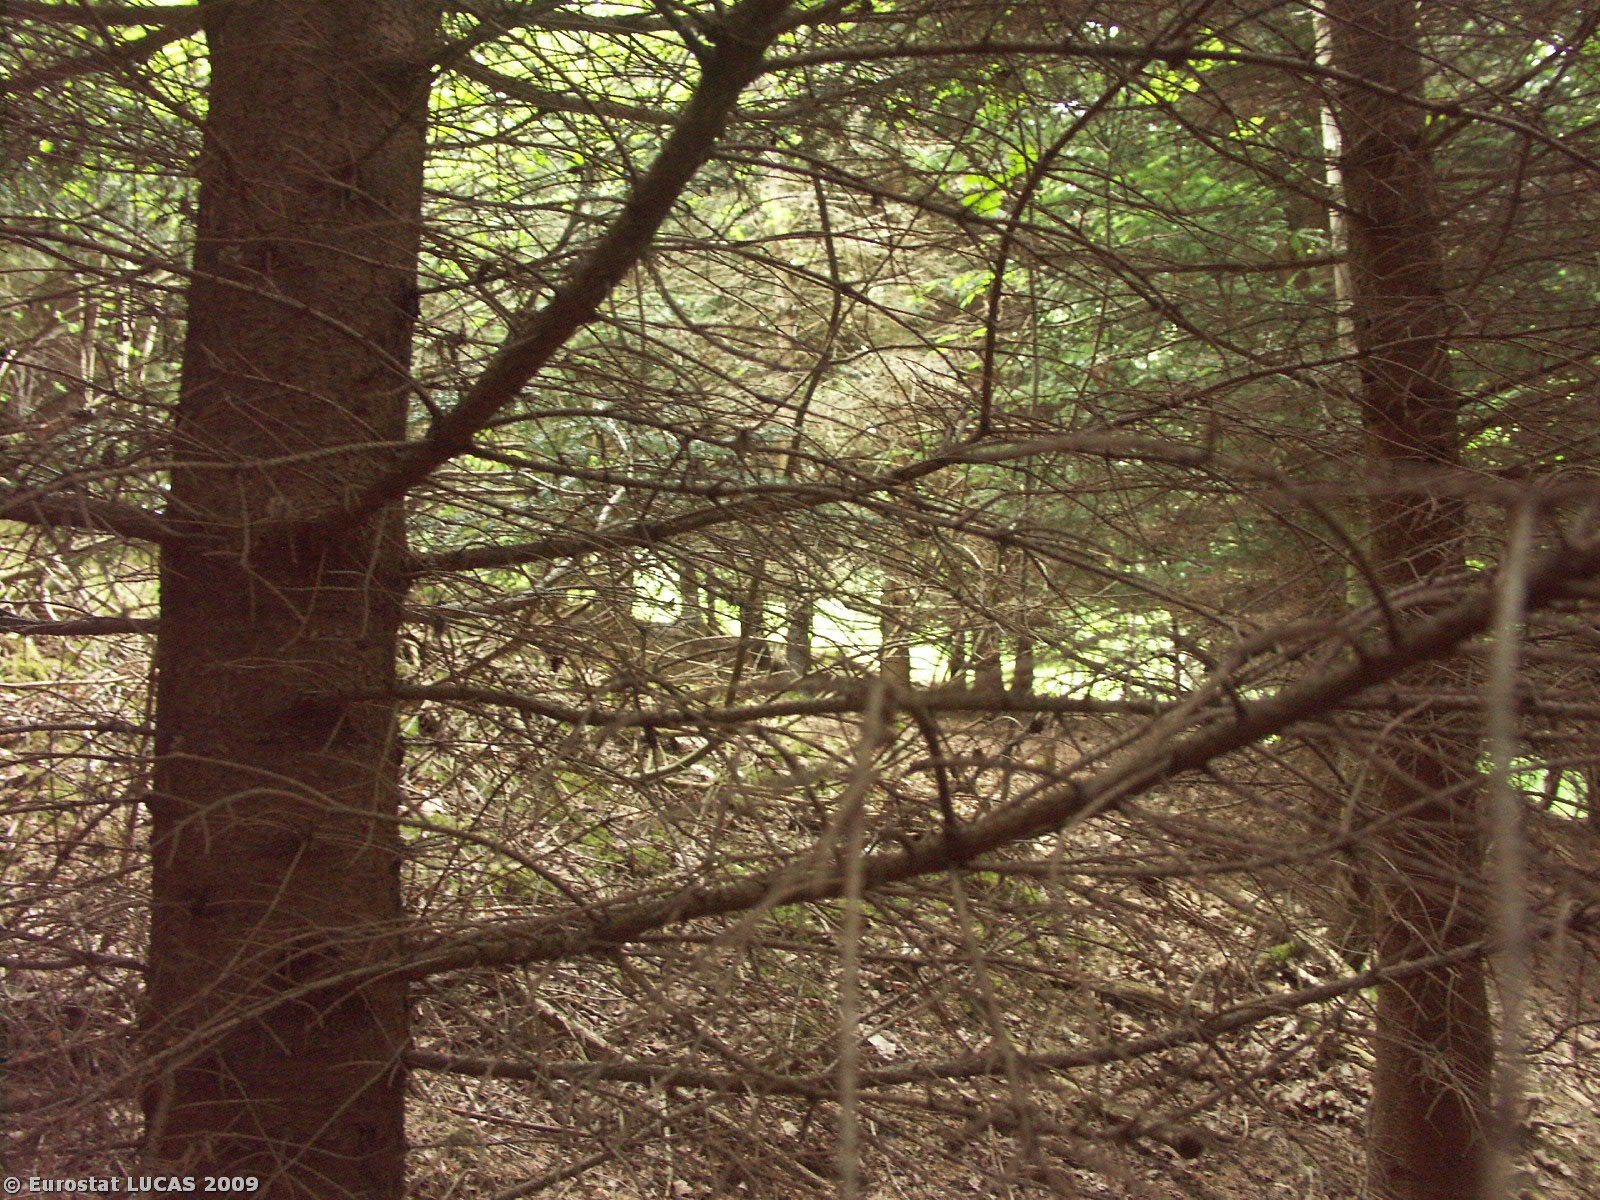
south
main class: Woodland
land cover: Coniferous woodland
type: hemiboreal forest and nemoral coniferous forest and mixed broadleaved-coniferous forest
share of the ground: > 75 %
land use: Forestry
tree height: > 5 m
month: May
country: CZ
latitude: 48.6860
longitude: 14.6059
